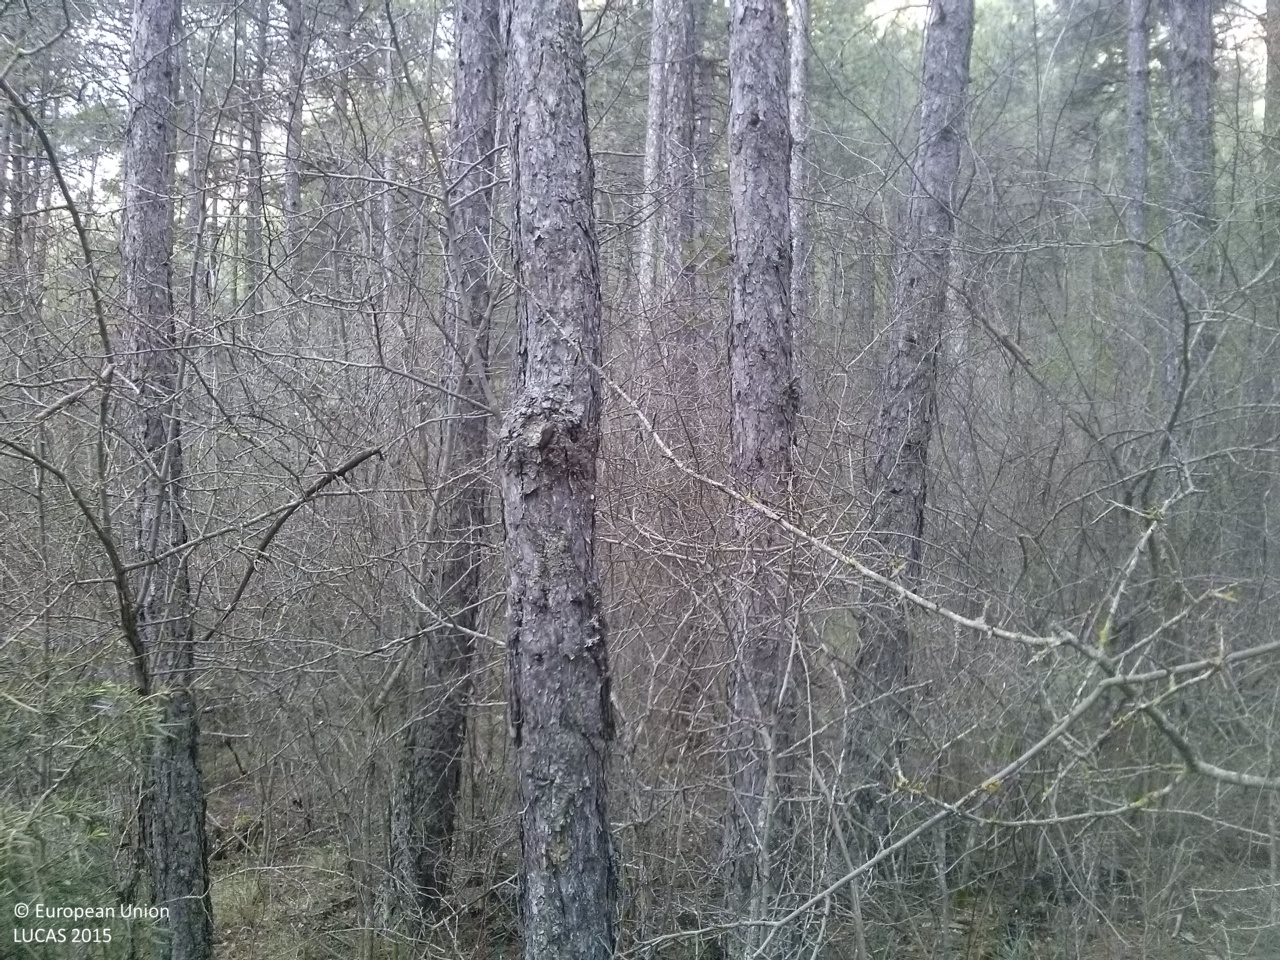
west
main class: Woodland
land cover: Pine dominated coniferous woodland
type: coniferous forest of the mediterranean region
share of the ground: > 75 %
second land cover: Shrubland without tree cover
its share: > 75 %
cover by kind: coniferous forest trees 75 %, shrubs 20 %, herbaceous plants 5 %
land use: Forestry
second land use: Agriculture (excluding fallow land and kitchen gardens)
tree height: > 5 m
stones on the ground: < 10 %
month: April
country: ES
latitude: 40.2168
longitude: -1.8951
